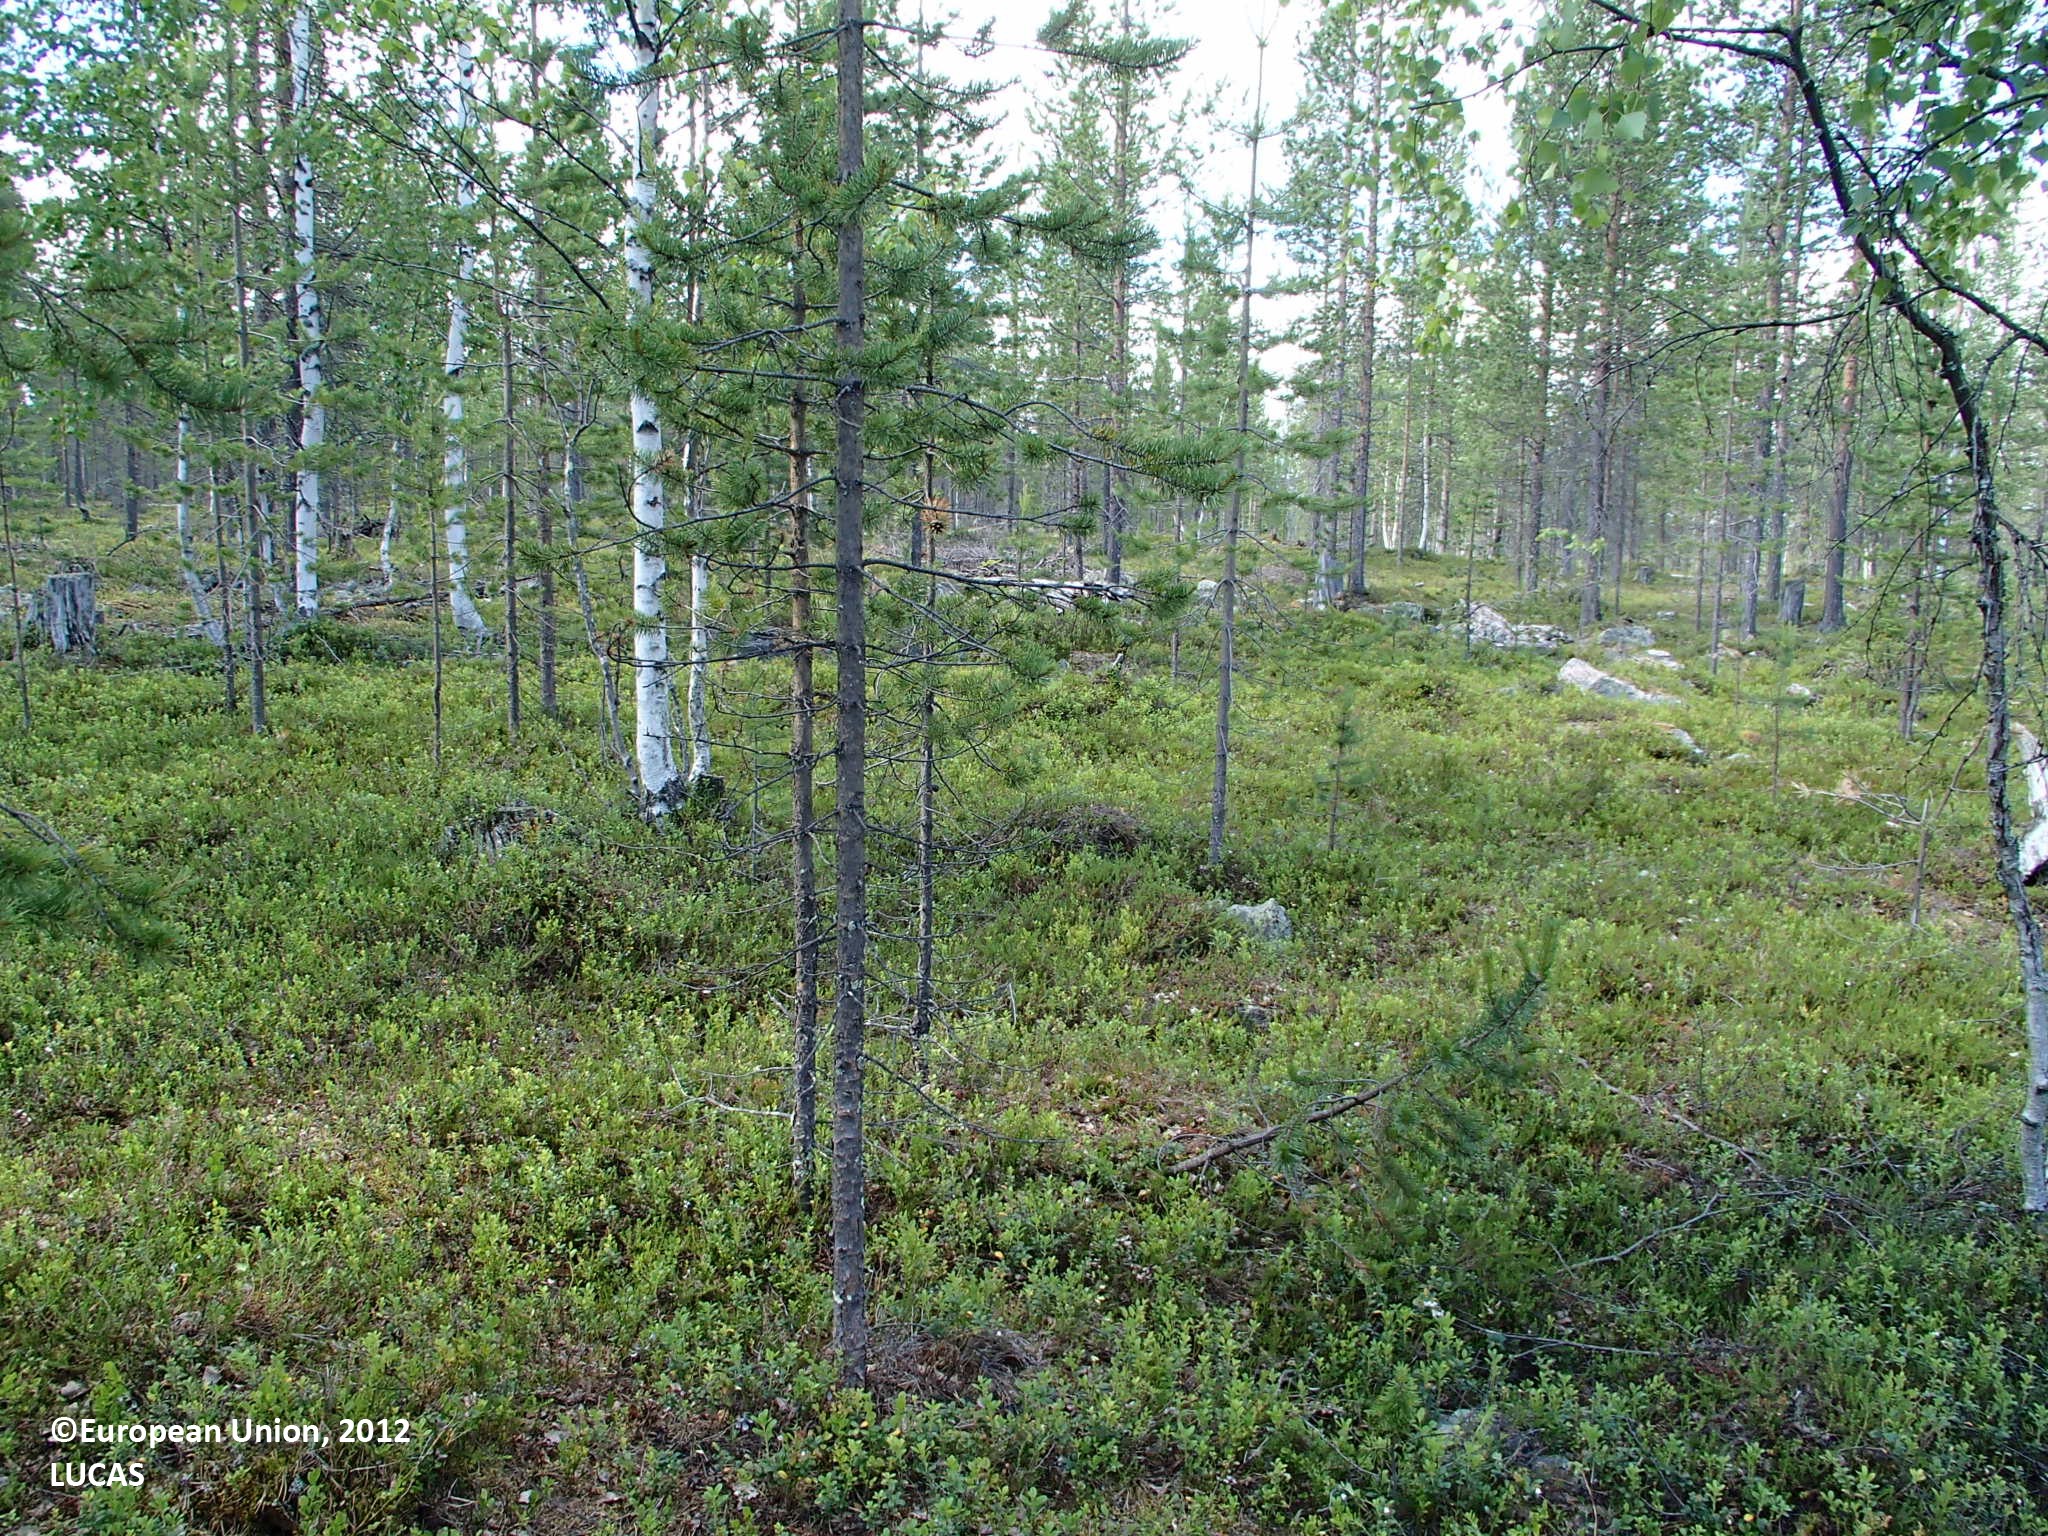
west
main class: Woodland
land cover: Pine dominated mixed woodland
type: boreal forest
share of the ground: 25 - 50 %
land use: Forestry
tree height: > 5 m
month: July
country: FI
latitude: 67.1804
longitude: 25.5592
